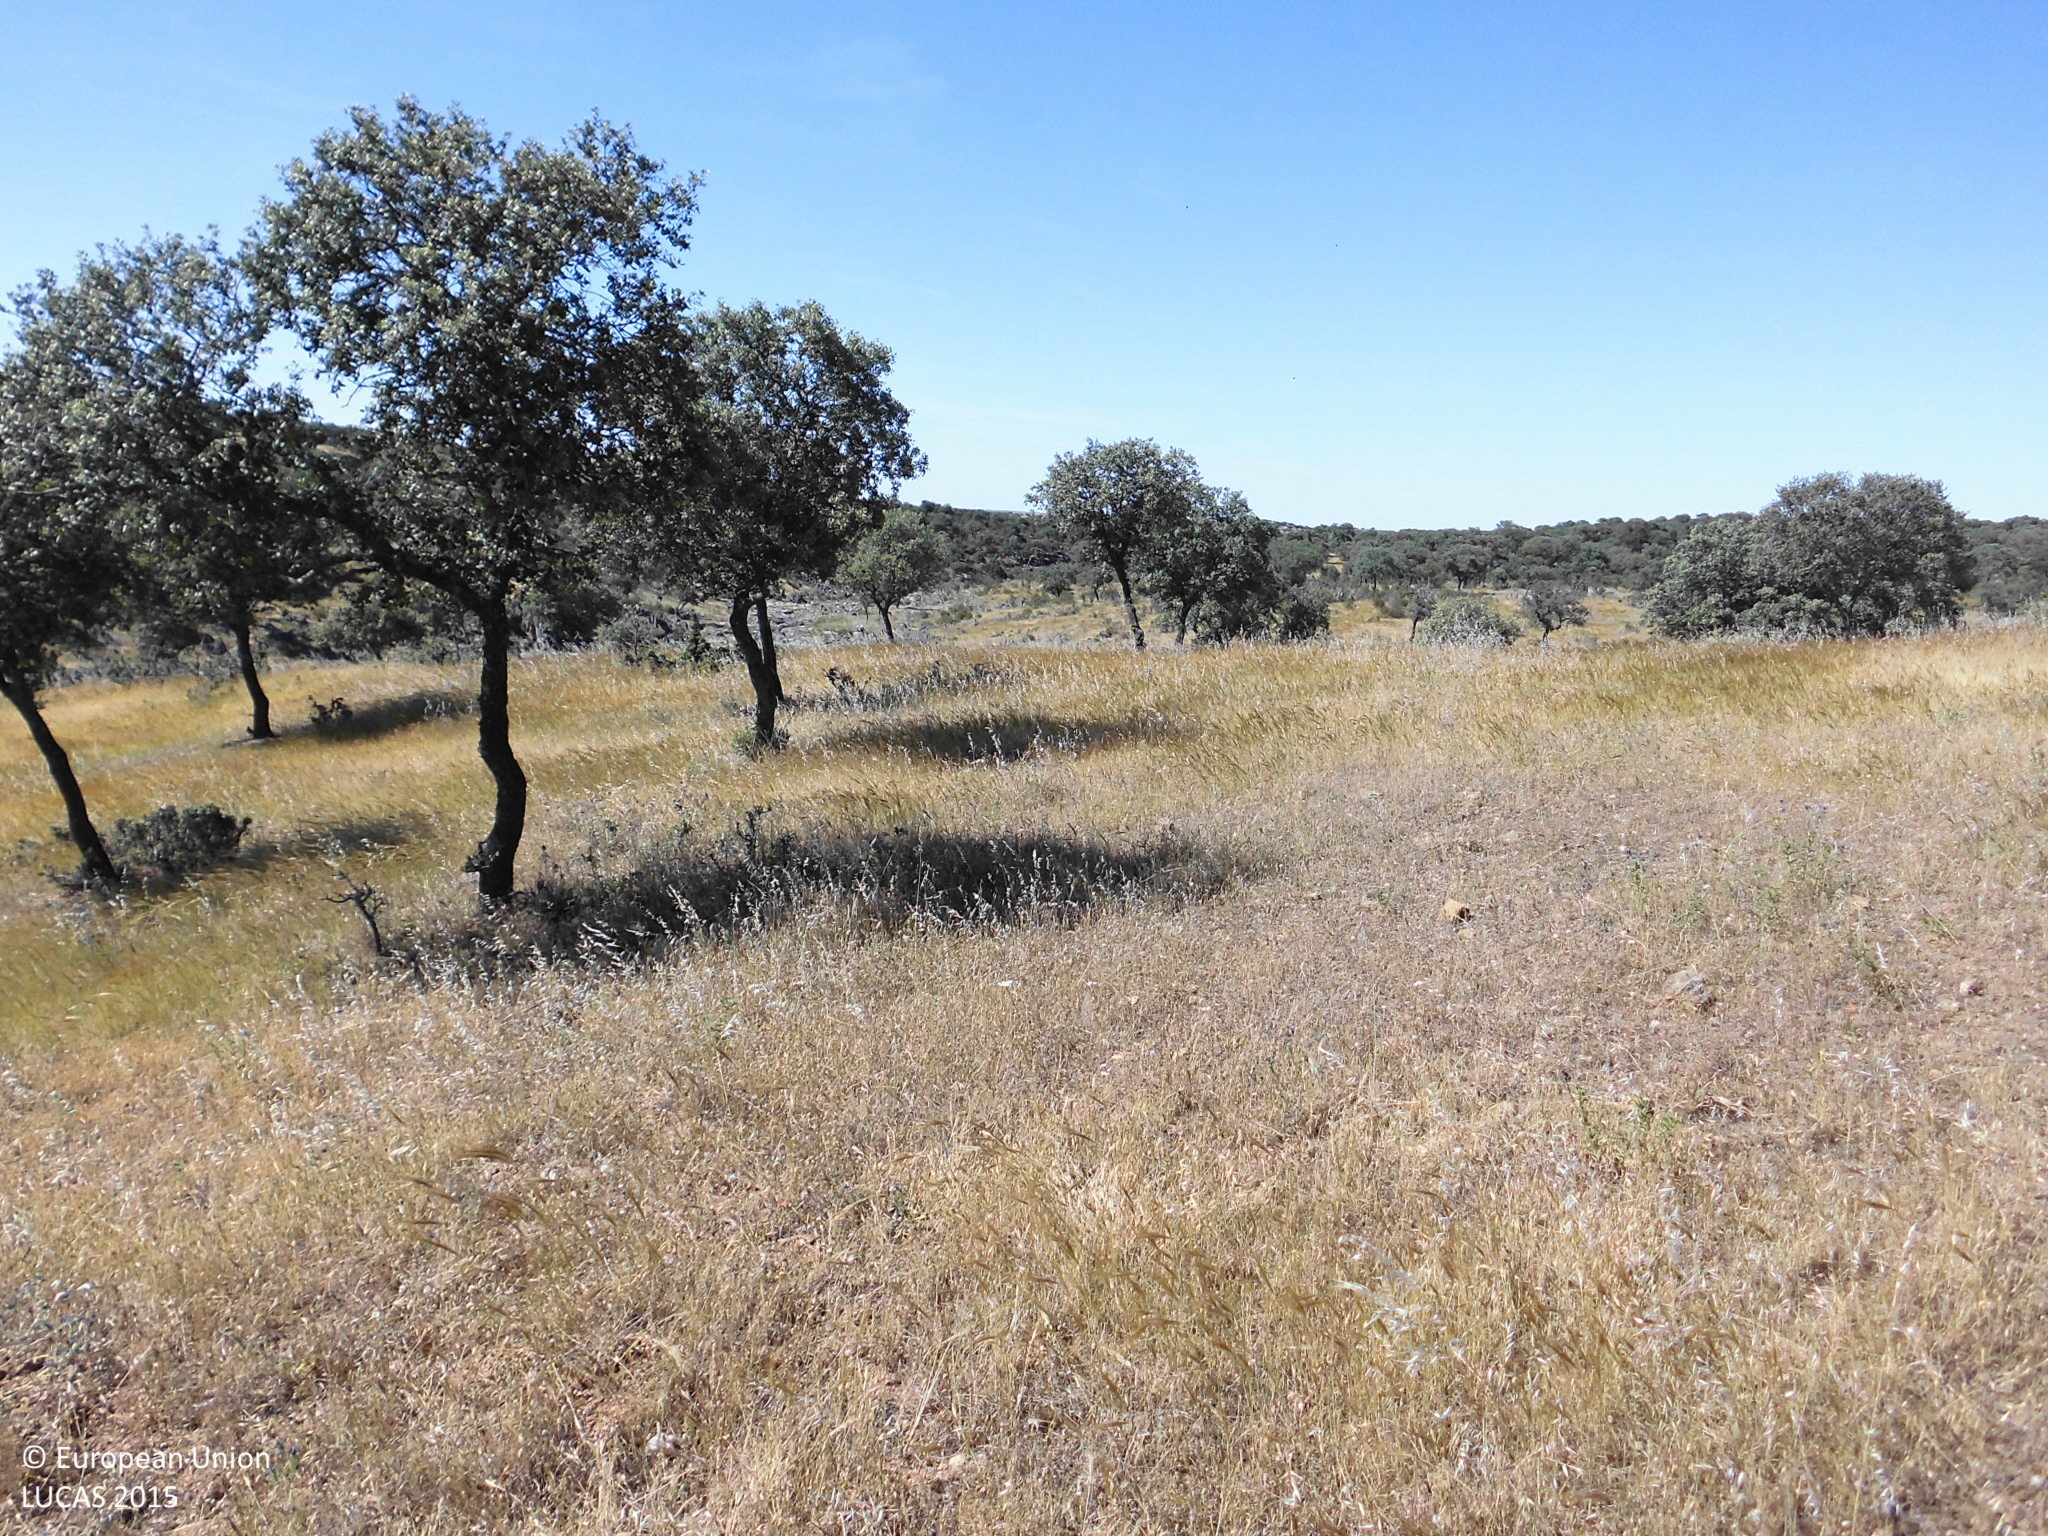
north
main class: Woodland
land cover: Broadleaved woodland
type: broadleaved evergreen forest
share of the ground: 10 - 25 %
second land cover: Grassland without tree/shrub cover
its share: > 75 %
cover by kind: herbaceous plants 85 %, broadleaved forest trees 15 %
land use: Forestry
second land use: Agriculture (excluding fallow land and kitchen gardens)
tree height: > 5 m
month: May
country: ES
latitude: 39.4443
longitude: -6.8445
